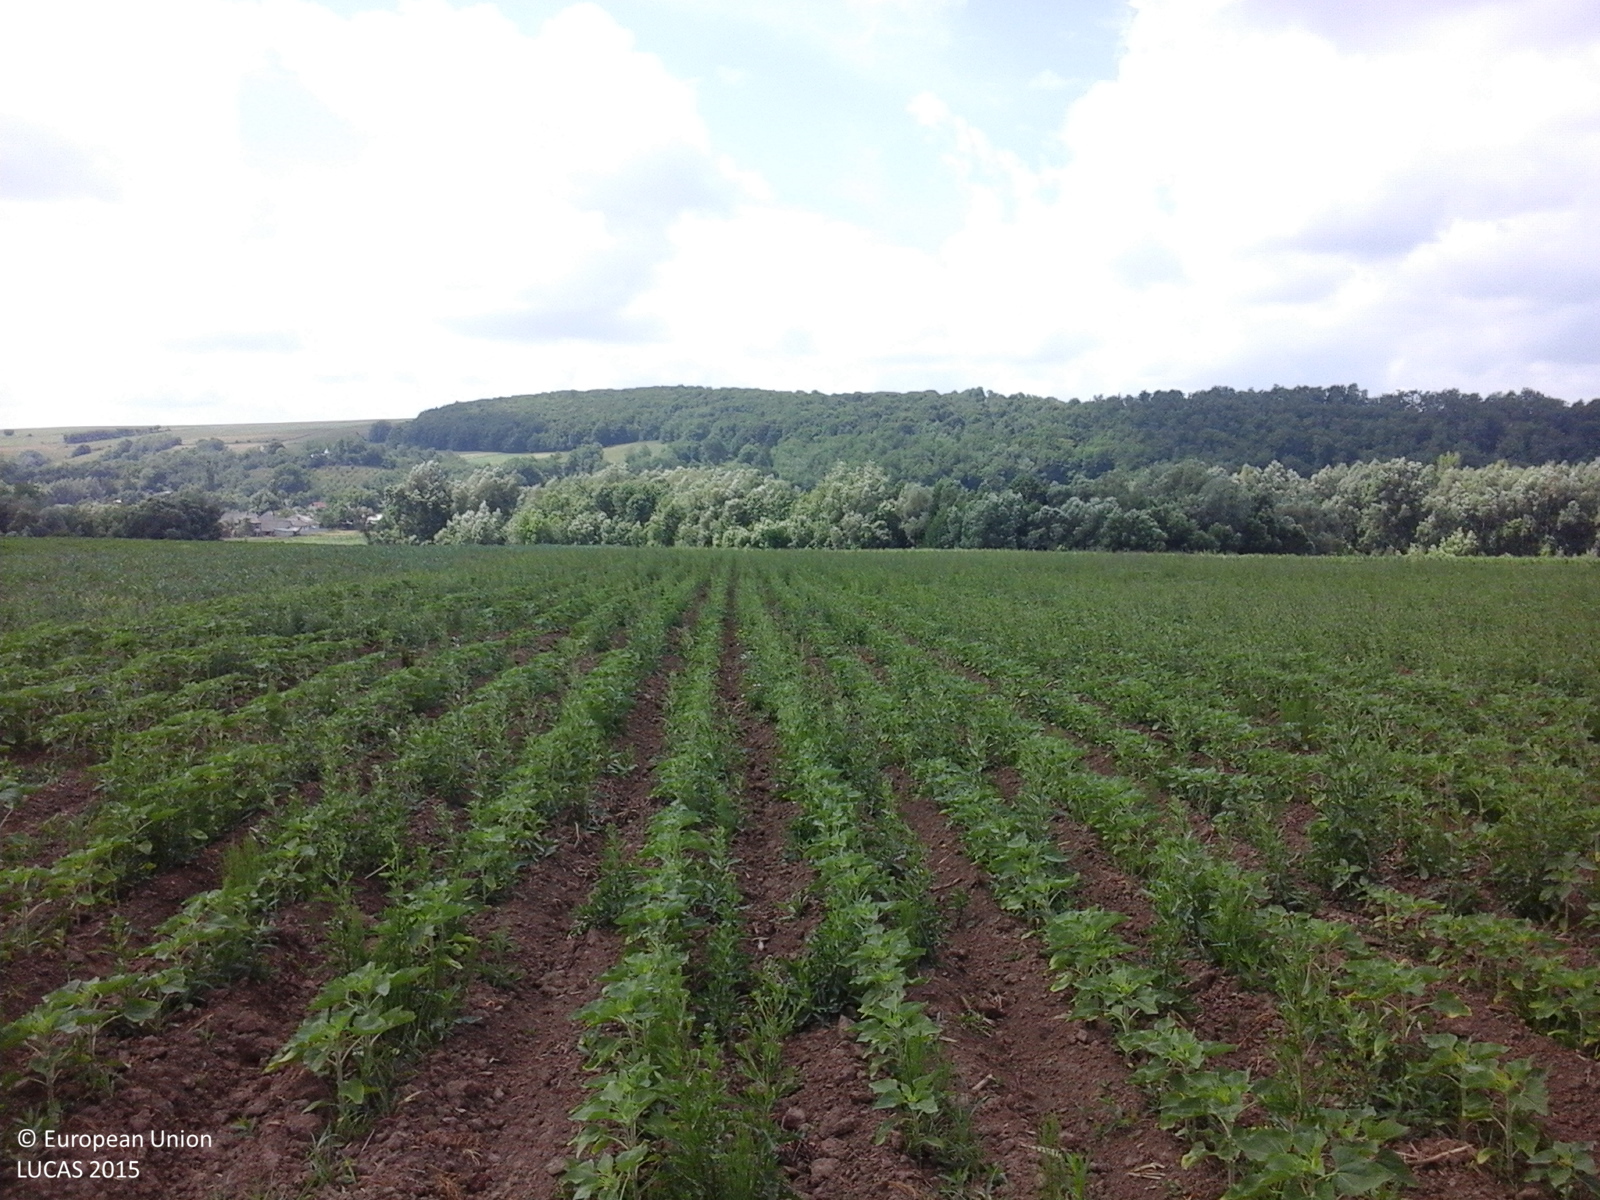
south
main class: Cropland
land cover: Sunflower
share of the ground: 25 - 50 %
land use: Agriculture (excluding fallow land and kitchen gardens)
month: June
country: RO
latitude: 47.0789
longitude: 26.6183
